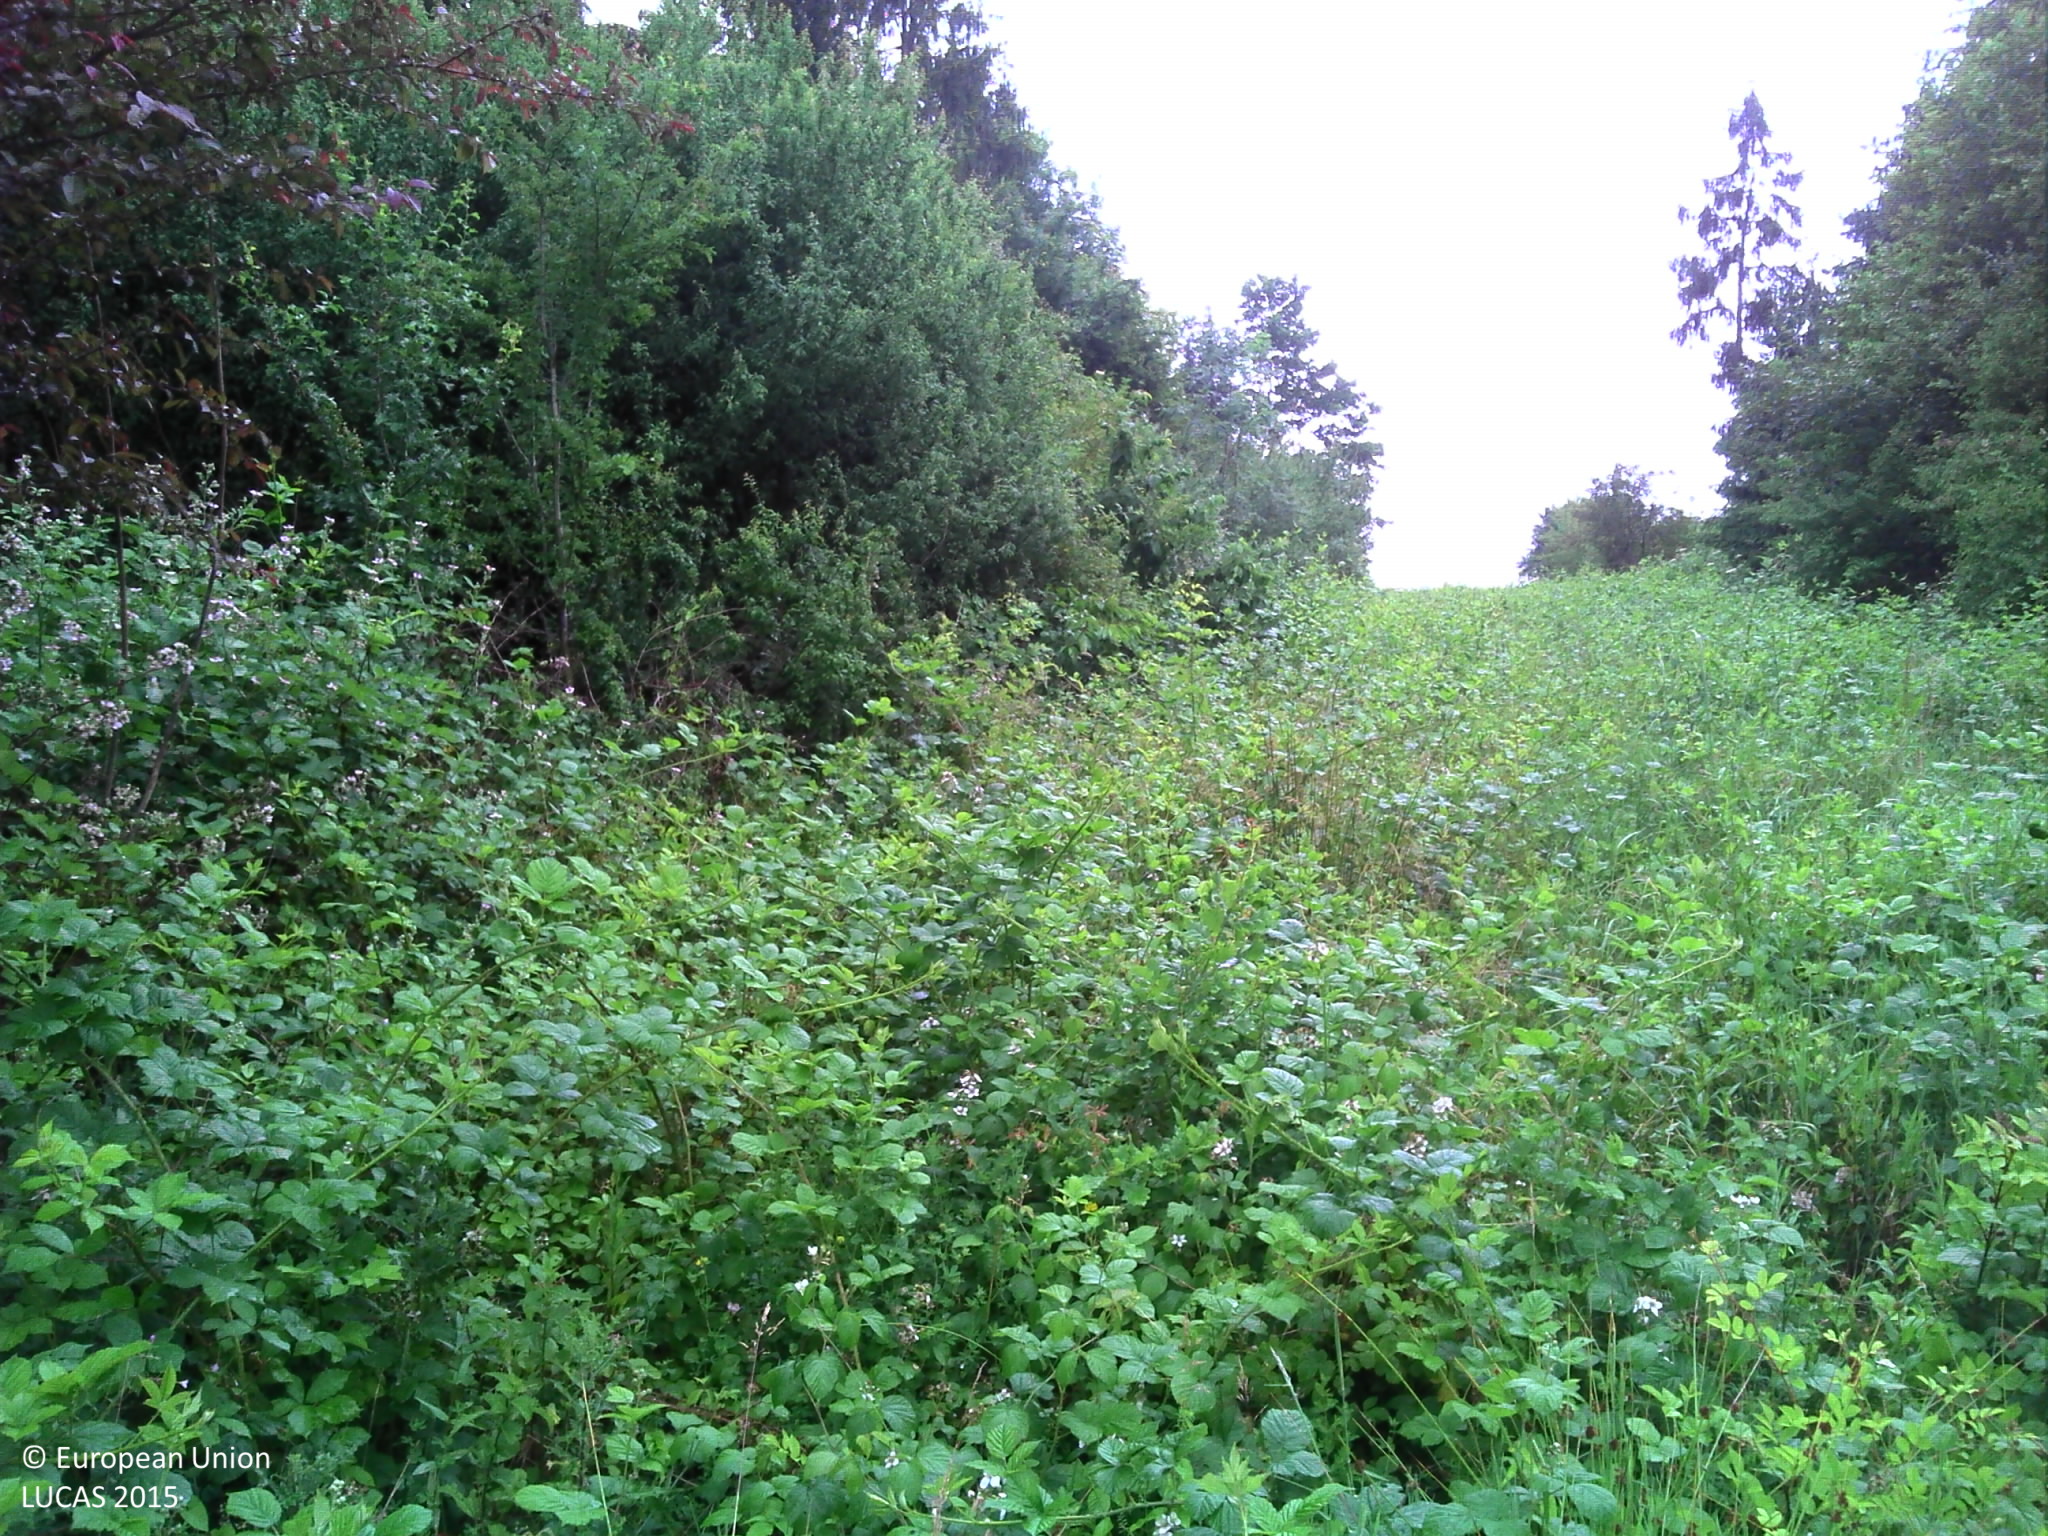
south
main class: Shrubland
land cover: Shrubland without tree cover
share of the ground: > 75 %
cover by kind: shrubs 90 %, herbaceous plants 10 %
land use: Semi-natural and natural areas not in use
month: June
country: FR
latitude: 48.6458
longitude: 6.2405
